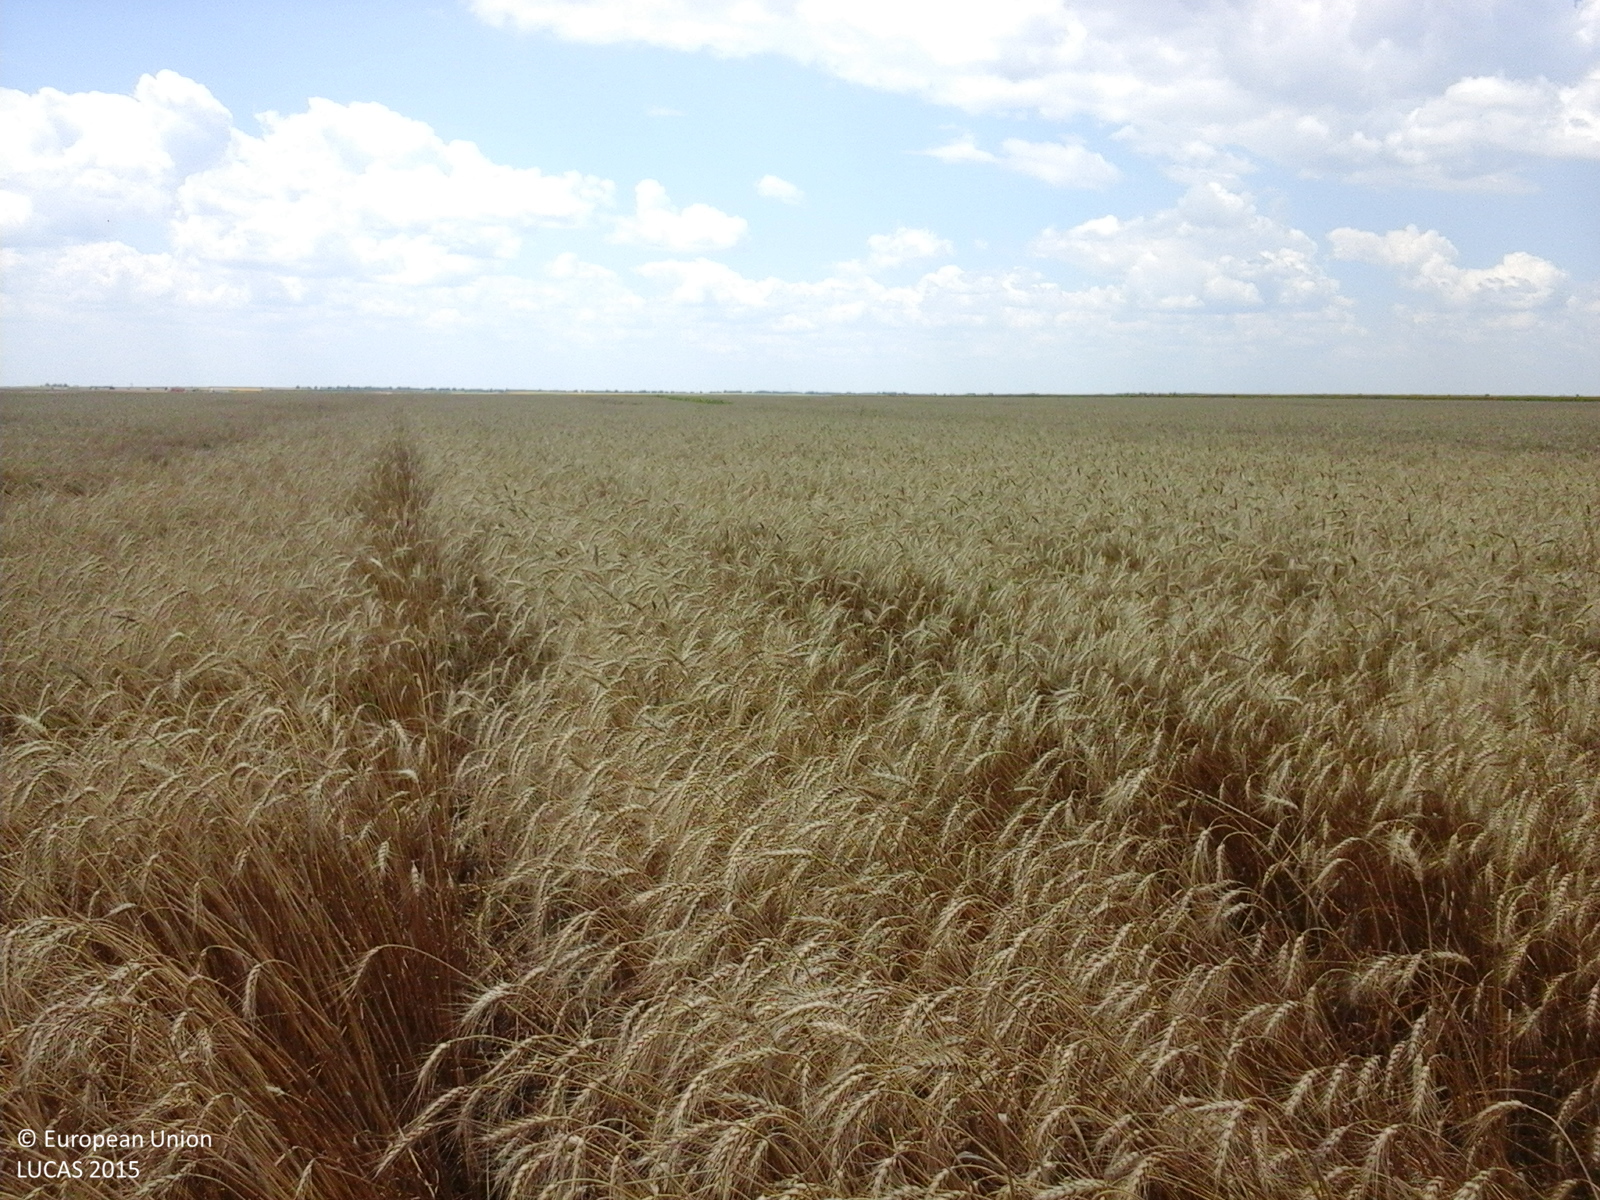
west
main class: Cropland
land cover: Common wheat
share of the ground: > 75 %
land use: Agriculture (excluding fallow land and kitchen gardens)
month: July
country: RO
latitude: 44.0072
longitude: 24.7259
